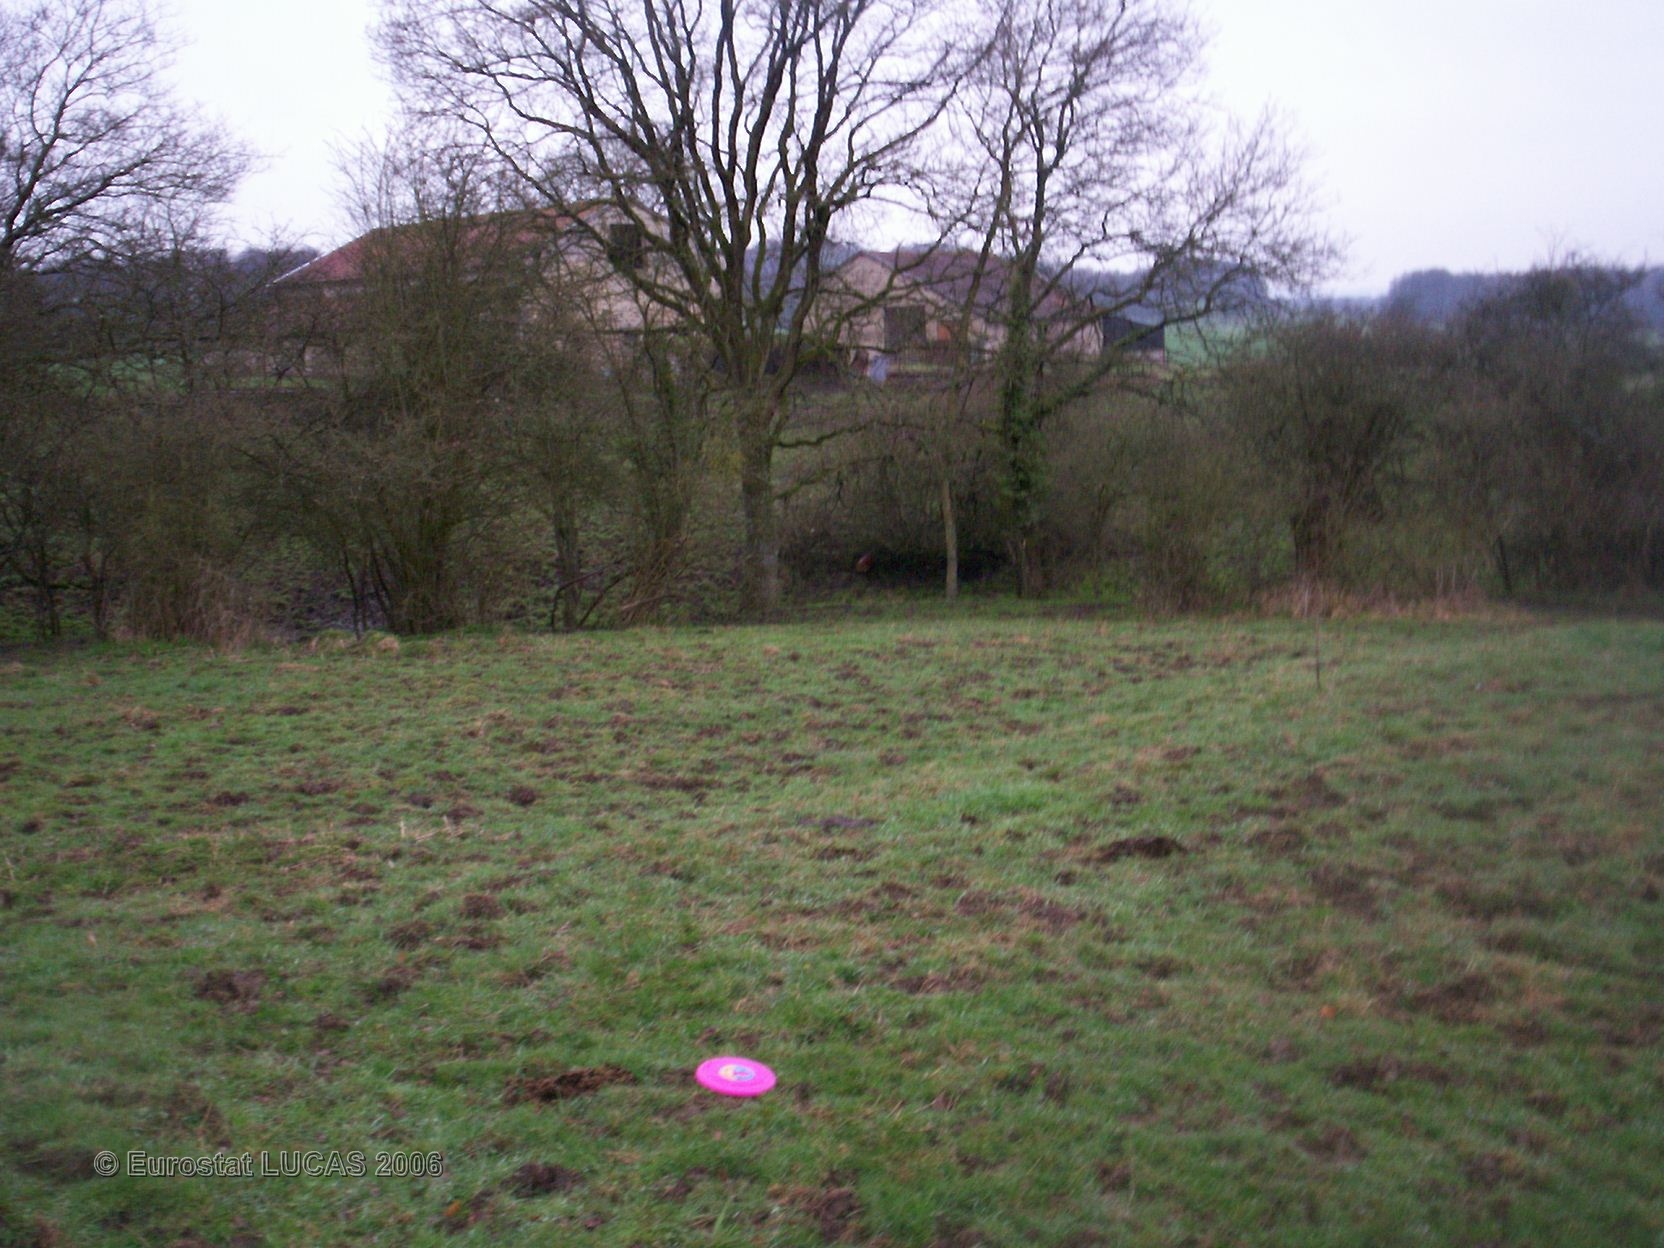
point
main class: Grassland
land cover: Grassland without tree/shrub cover
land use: Agriculture (excluding fallow land and kitchen gardens)
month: April
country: FR
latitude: 49.3204
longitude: 5.0588
